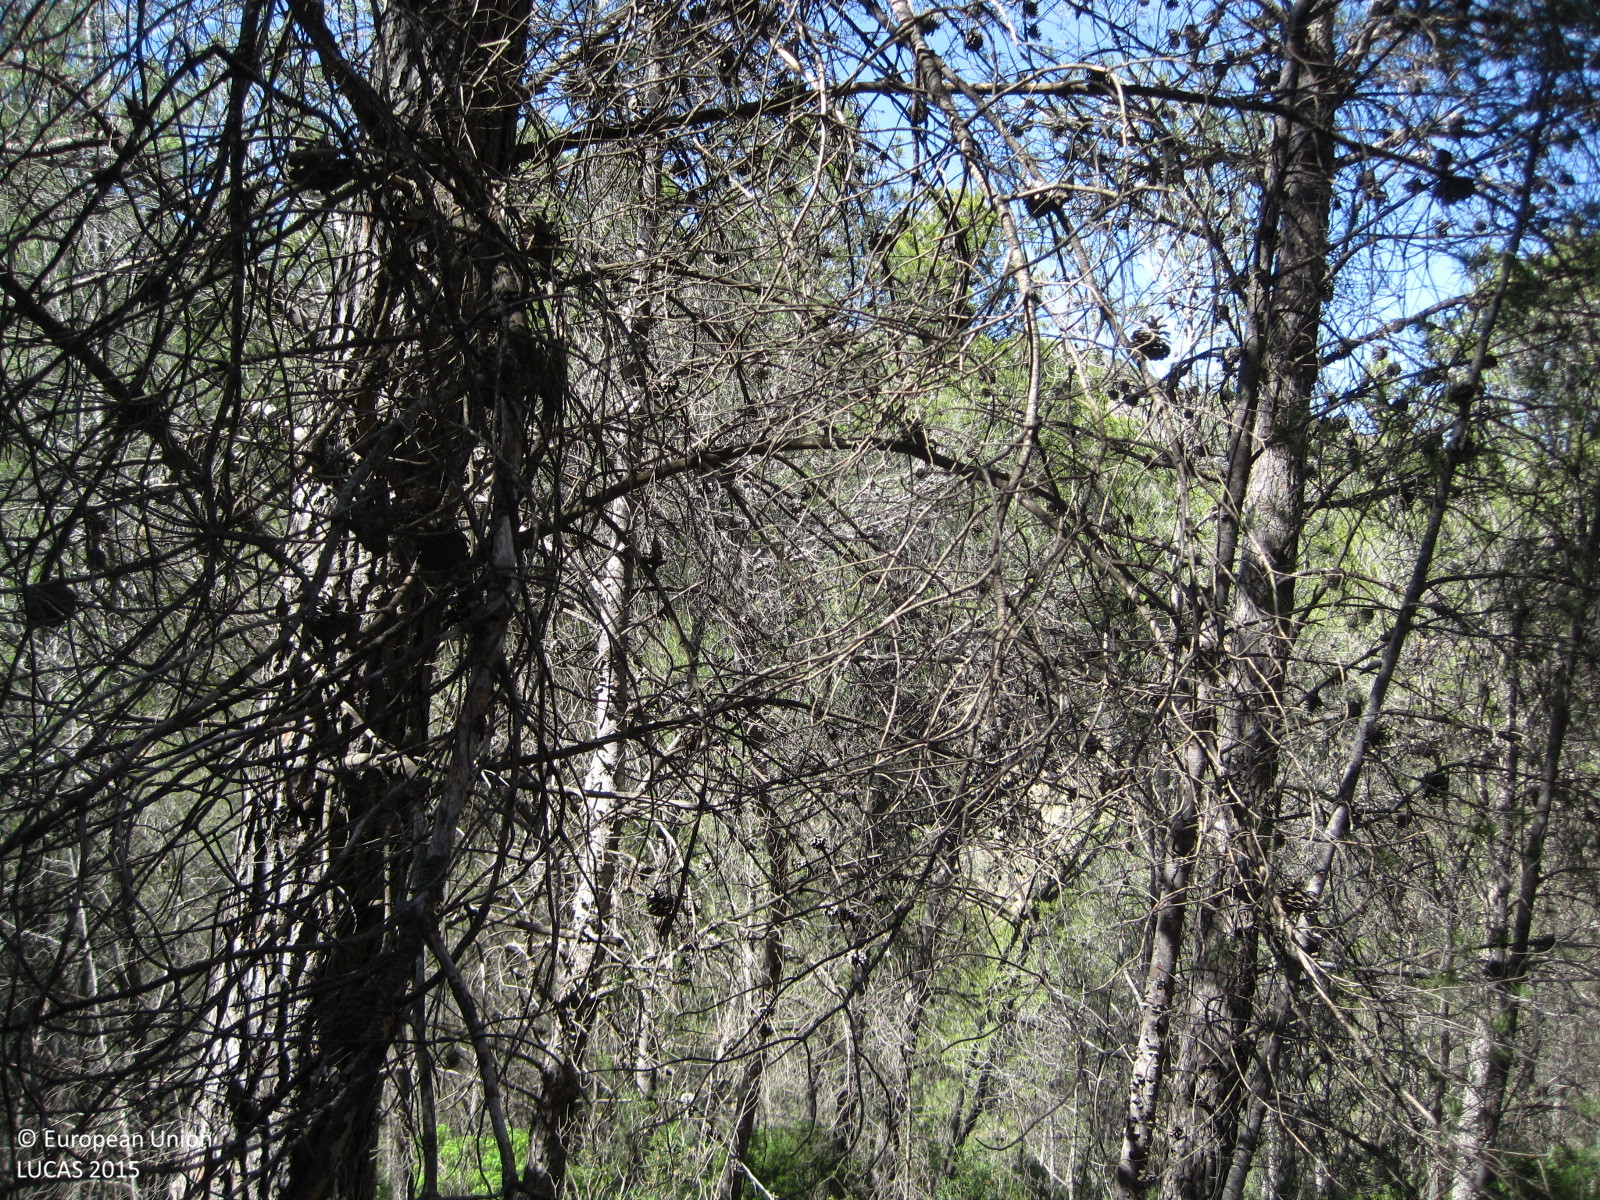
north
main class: Woodland
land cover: Pine dominated coniferous woodland
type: coniferous forest of the mediterranean region
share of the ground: > 75 %
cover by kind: coniferous forest trees 90 %, shrubs 10 %
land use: Semi-natural and natural areas not in use
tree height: > 5 m
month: May
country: ES
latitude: 39.3716
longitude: -0.8517
